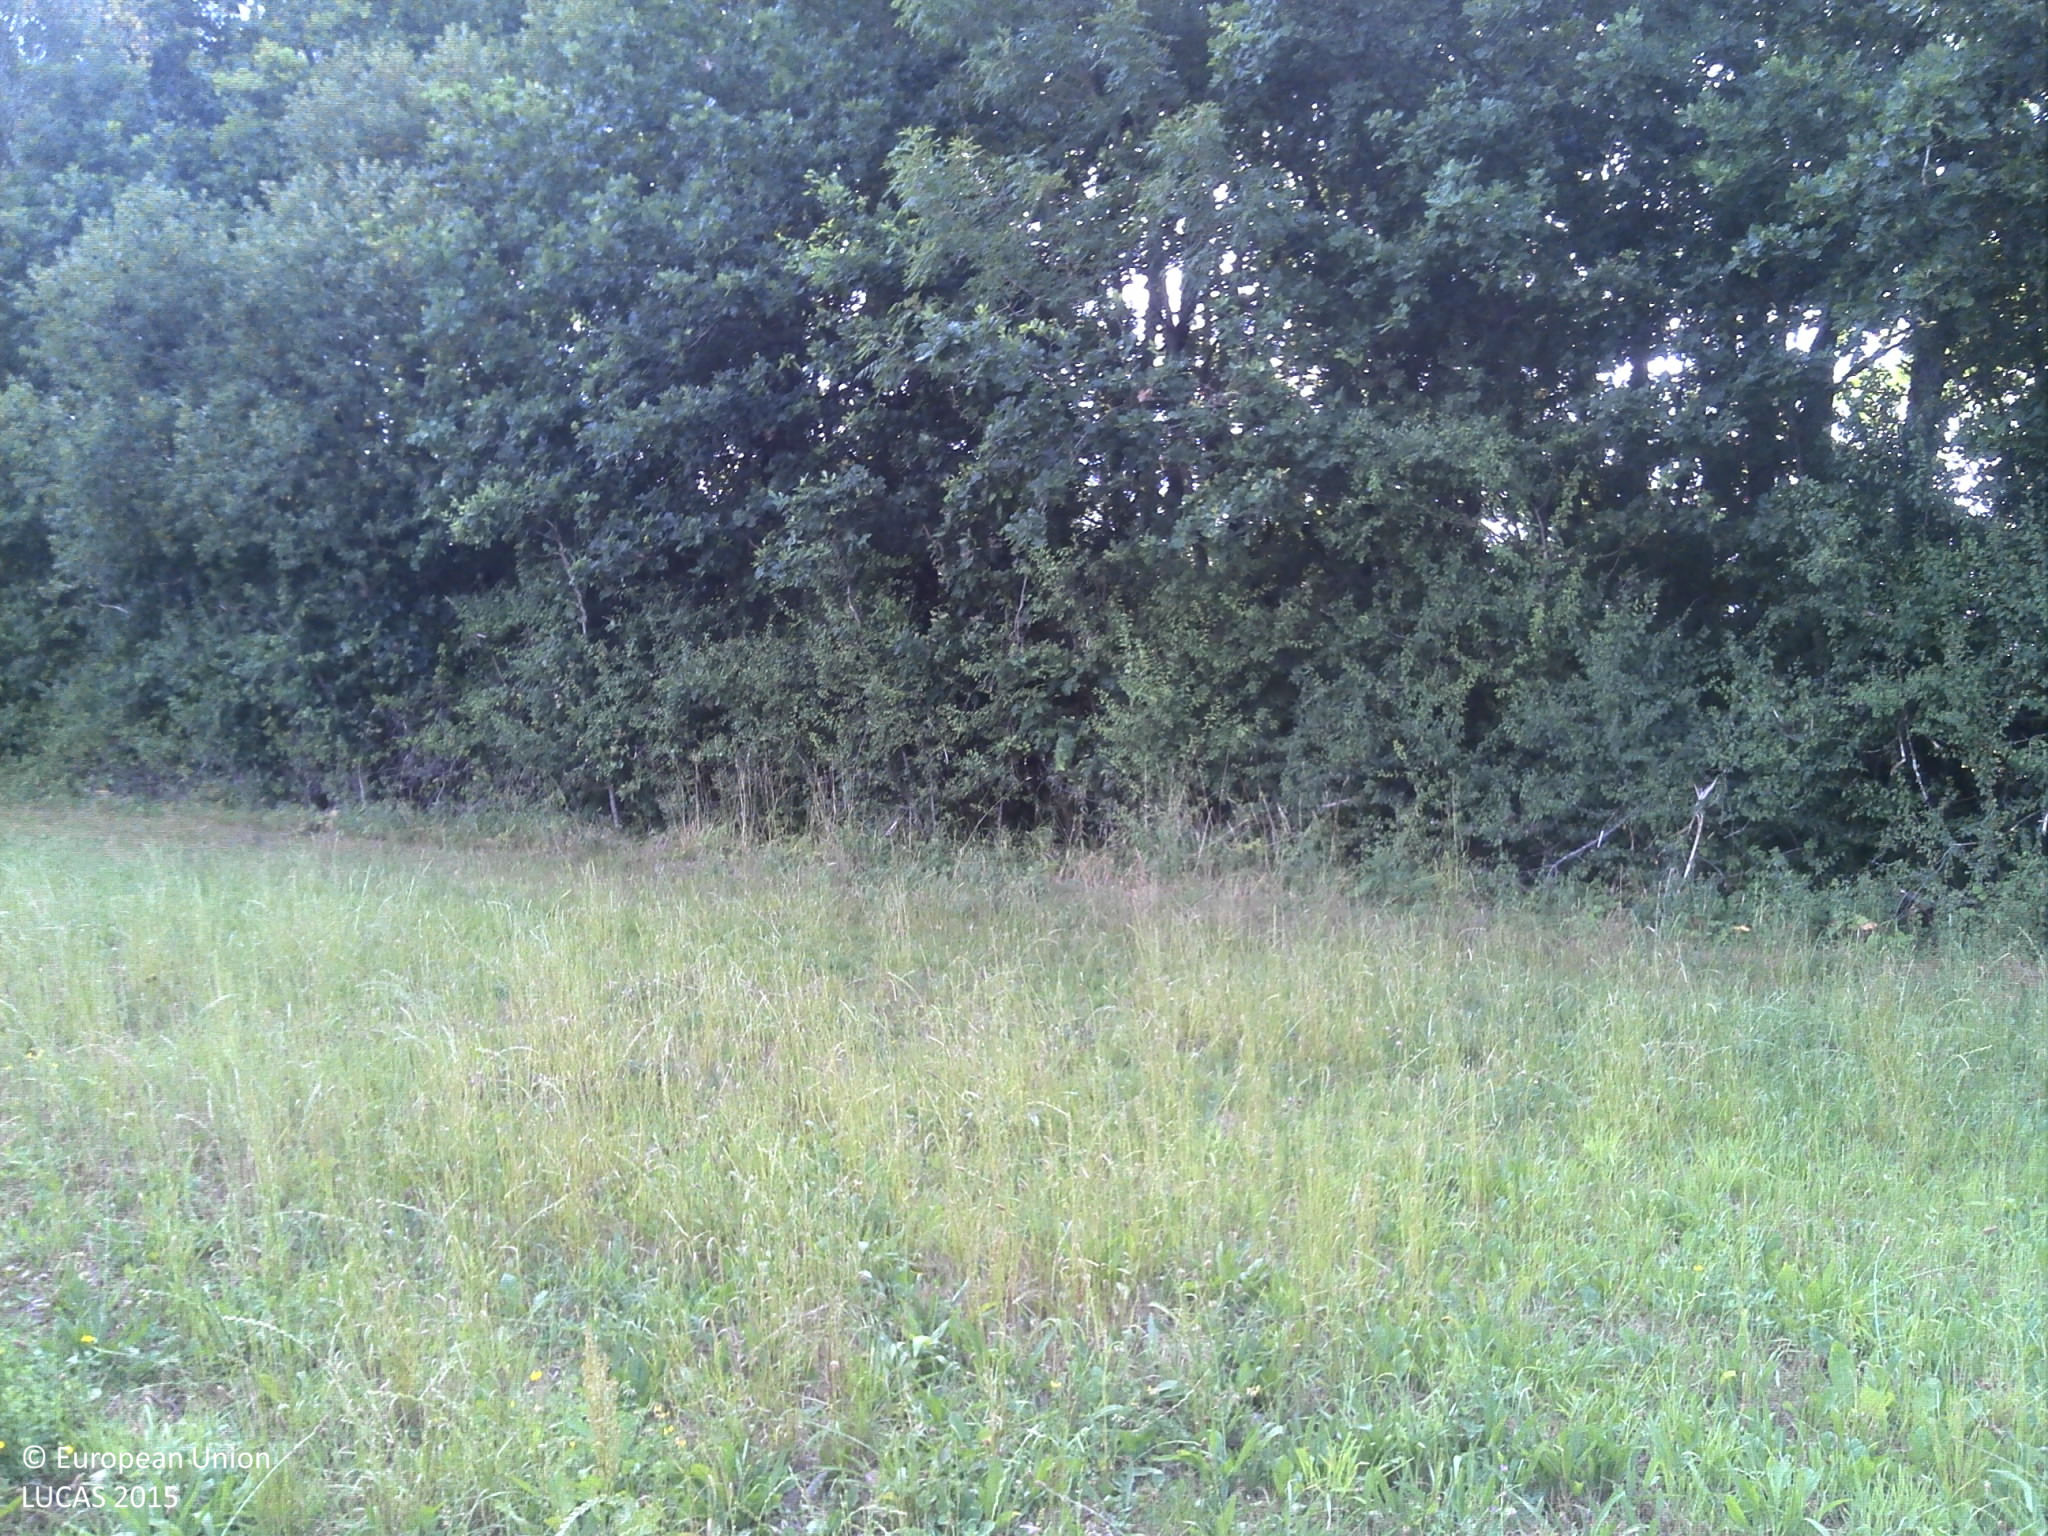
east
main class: Cropland
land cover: Rape and turnip rape
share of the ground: > 75 %
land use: Agriculture (excluding fallow land and kitchen gardens)
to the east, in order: Rape and turnip rape; Grassland without tree/shrub cover; Broadleaved woodland; Grassland without tree/shrub cover; Oats; Common wheat
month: July
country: FR
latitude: 49.2580
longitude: 4.8723
